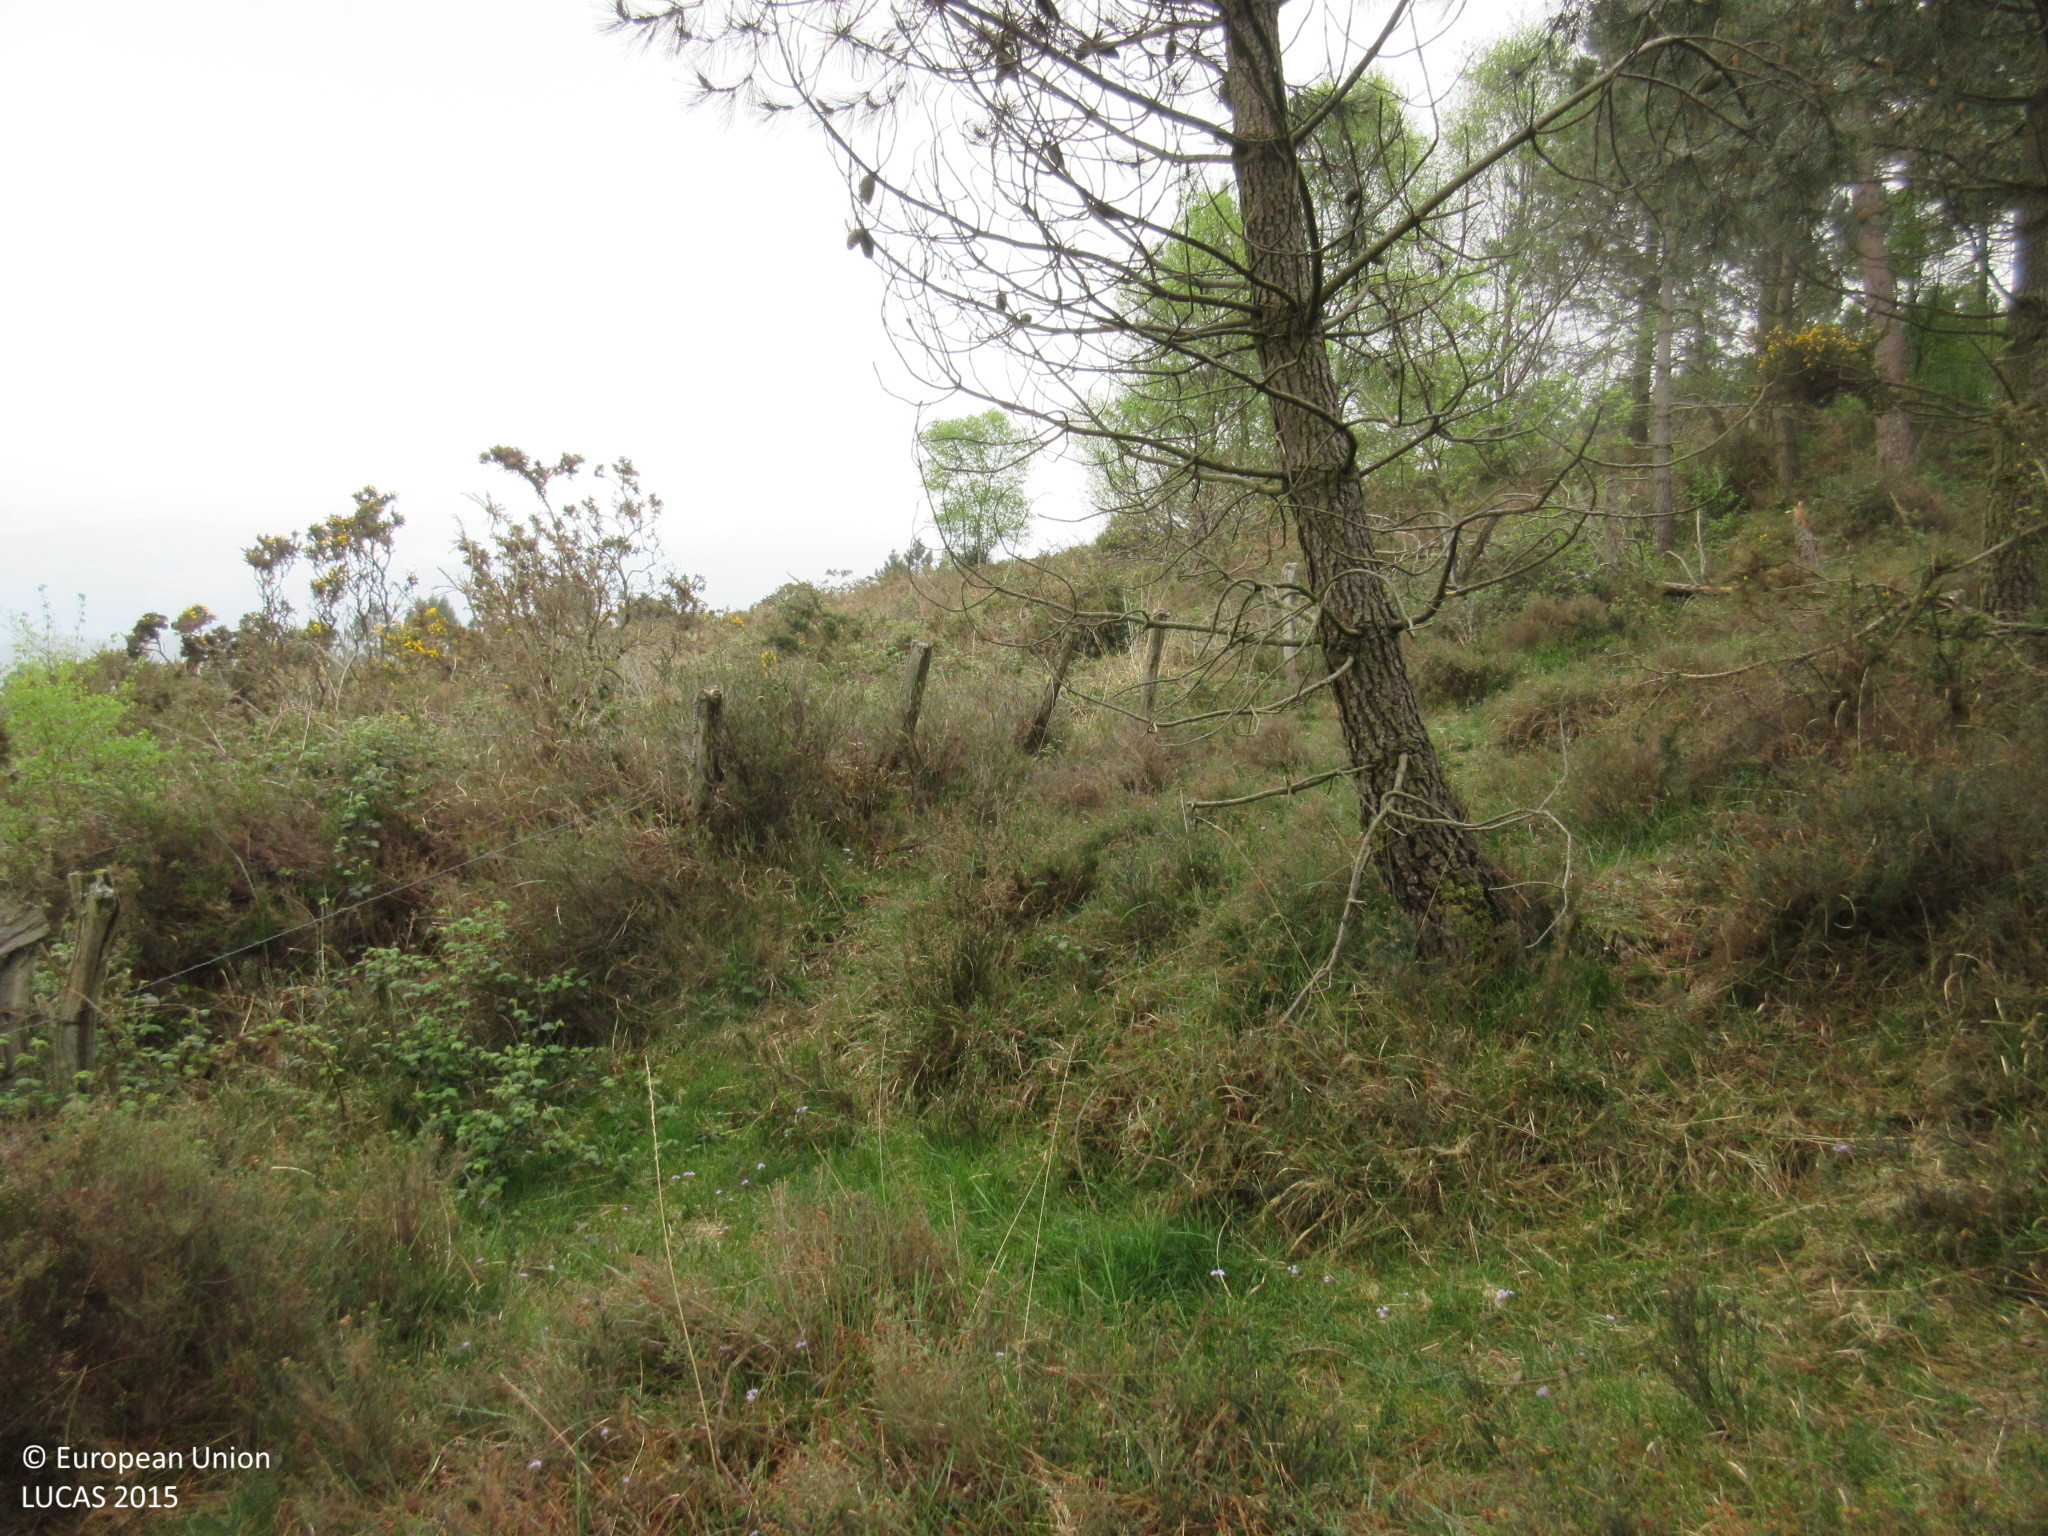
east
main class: Woodland
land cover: Pine dominated coniferous woodland
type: hemiboreal forest and nemoral coniferous forest and mixed broadleaved-coniferous forest
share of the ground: 50 - 75 %
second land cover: Shrubland without tree cover
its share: > 75 %
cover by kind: coniferous forest trees 70 %, shrubs 30 %
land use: Forestry
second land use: Agriculture (excluding fallow land and kitchen gardens)
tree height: > 5 m
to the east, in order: Pine dominated coniferous woodland; Shrubland without tree cover; Fences; Shrubland without tree cover; Shrubland with sparse tree cover
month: April
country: ES
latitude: 43.4894
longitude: -6.7673
